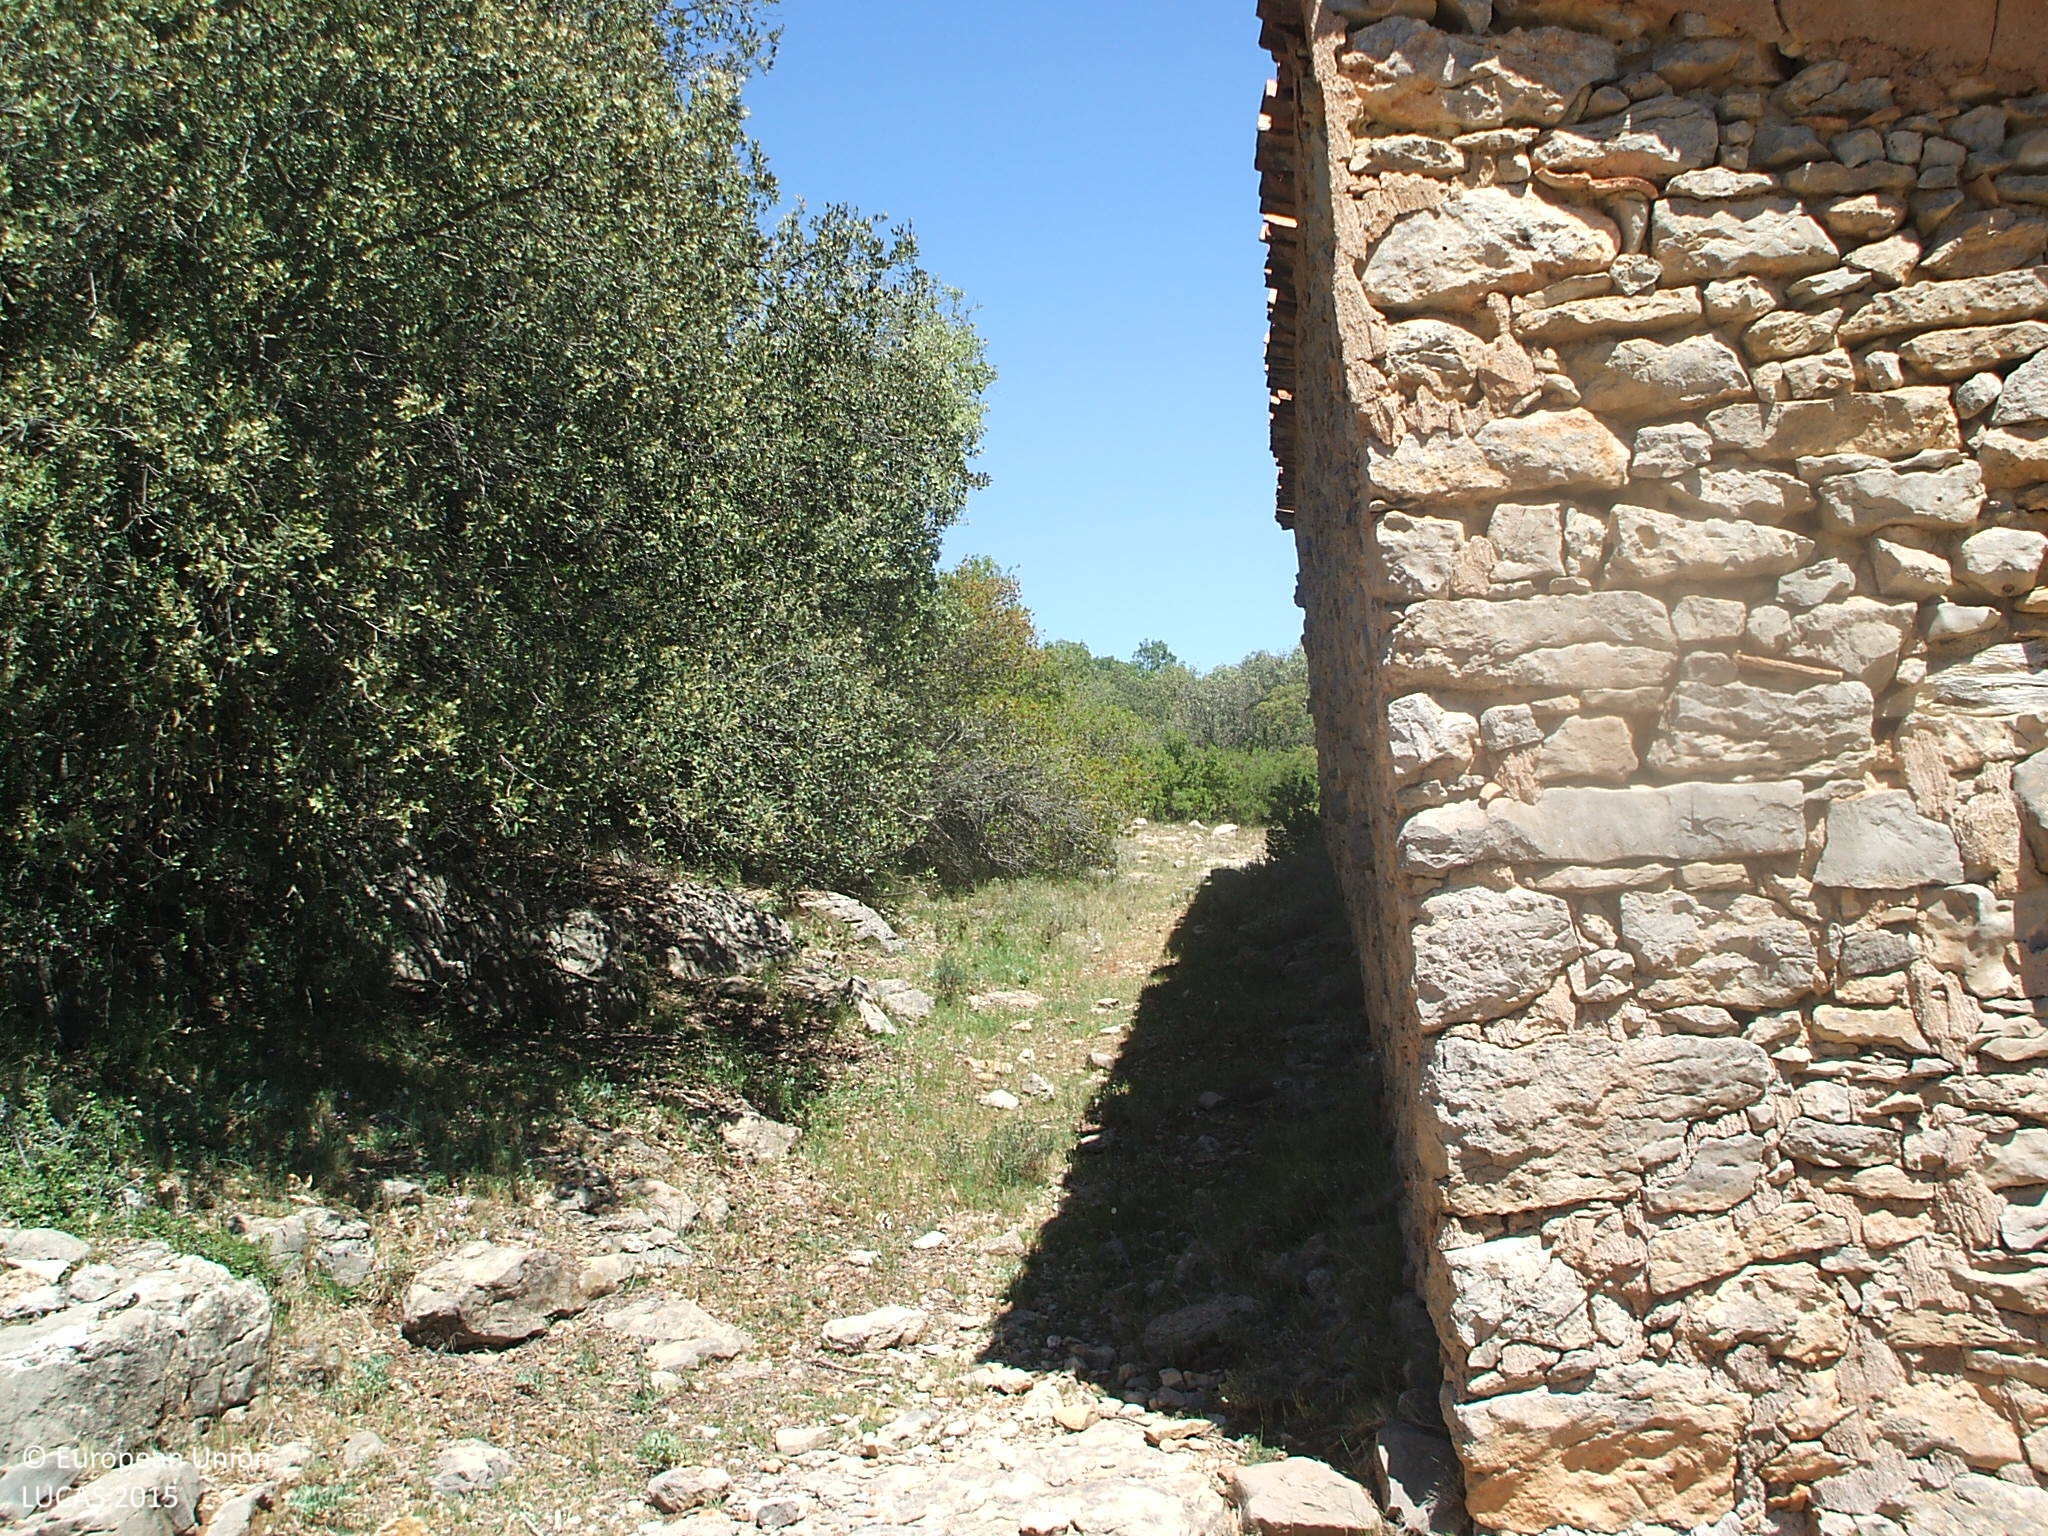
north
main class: Grassland
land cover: Grassland without tree/shrub cover
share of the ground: 25 - 50 %
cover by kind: consolidated bare surface 65 %, herbaceous plants 35 %
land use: Semi-natural and natural areas not in use
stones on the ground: > 50 %
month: May
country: ES
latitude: 40.0394
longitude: -0.7524
